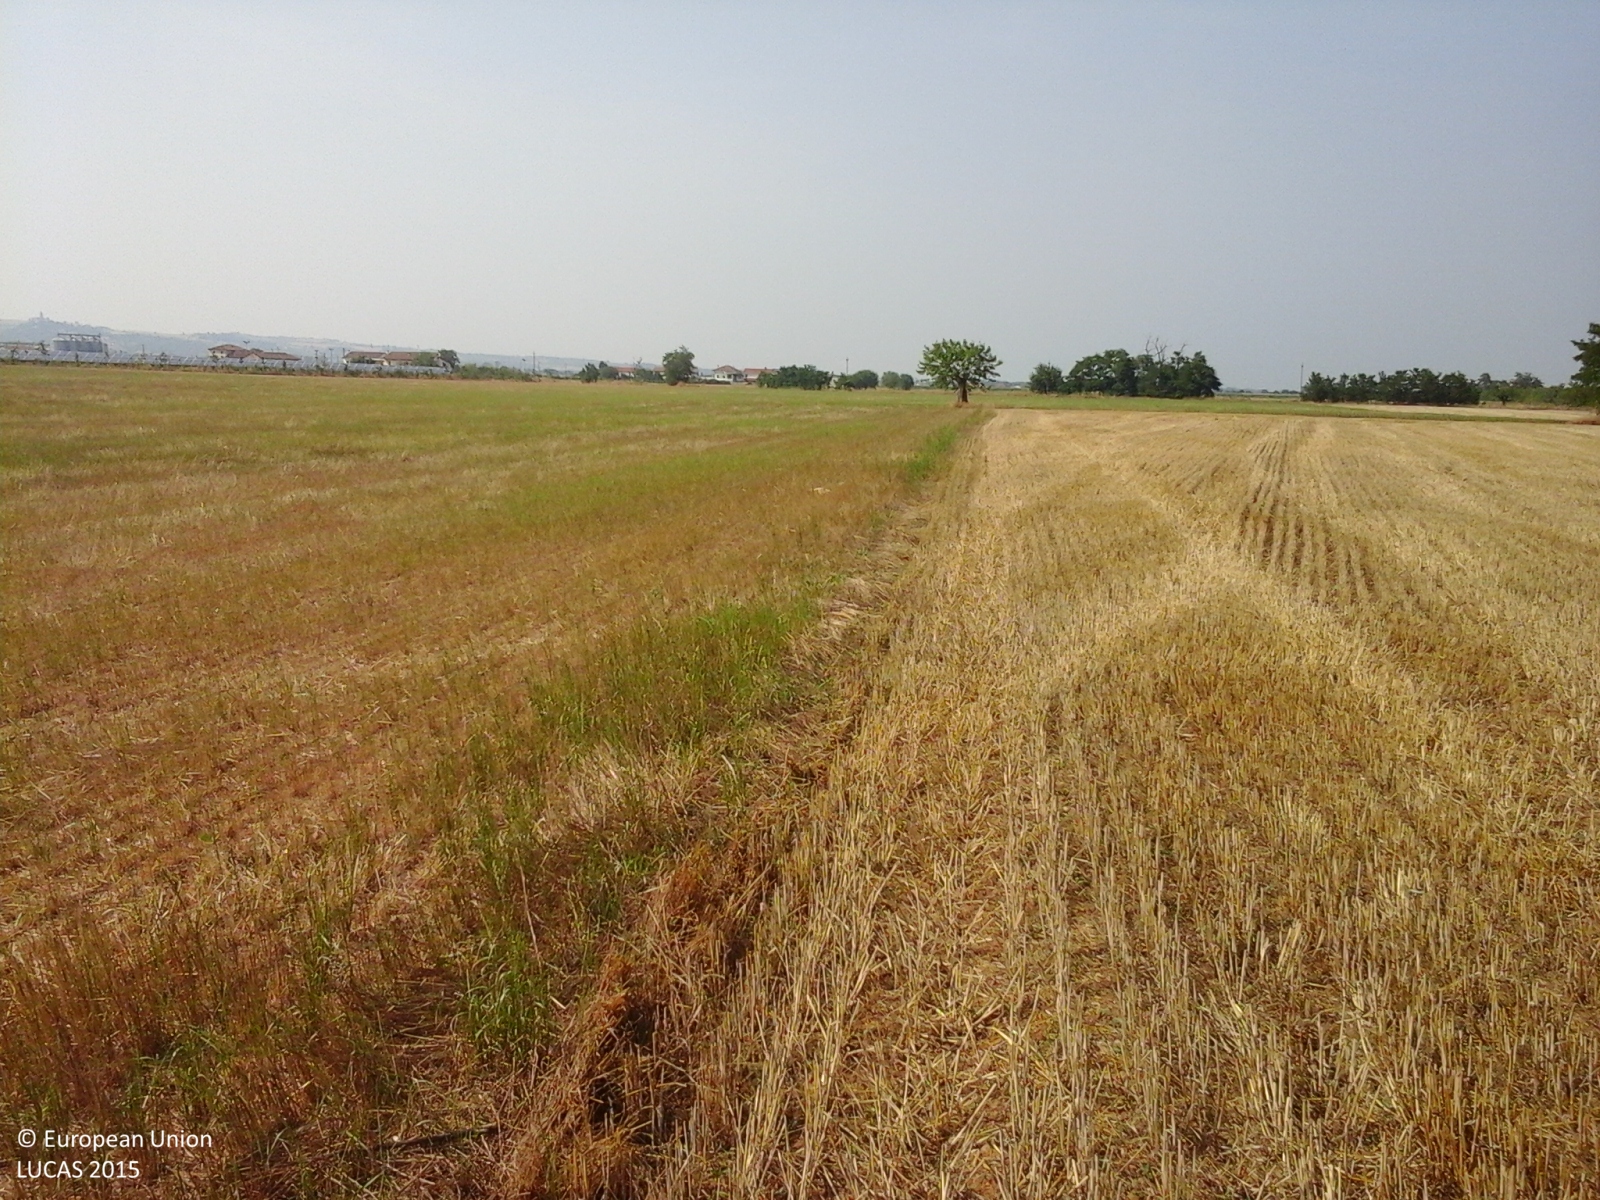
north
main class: Cropland
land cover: Common wheat
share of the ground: 10 - 25 %
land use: Agriculture (excluding fallow land and kitchen gardens)
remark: Harvested field
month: July
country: IT
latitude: 44.9018
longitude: 8.7234
